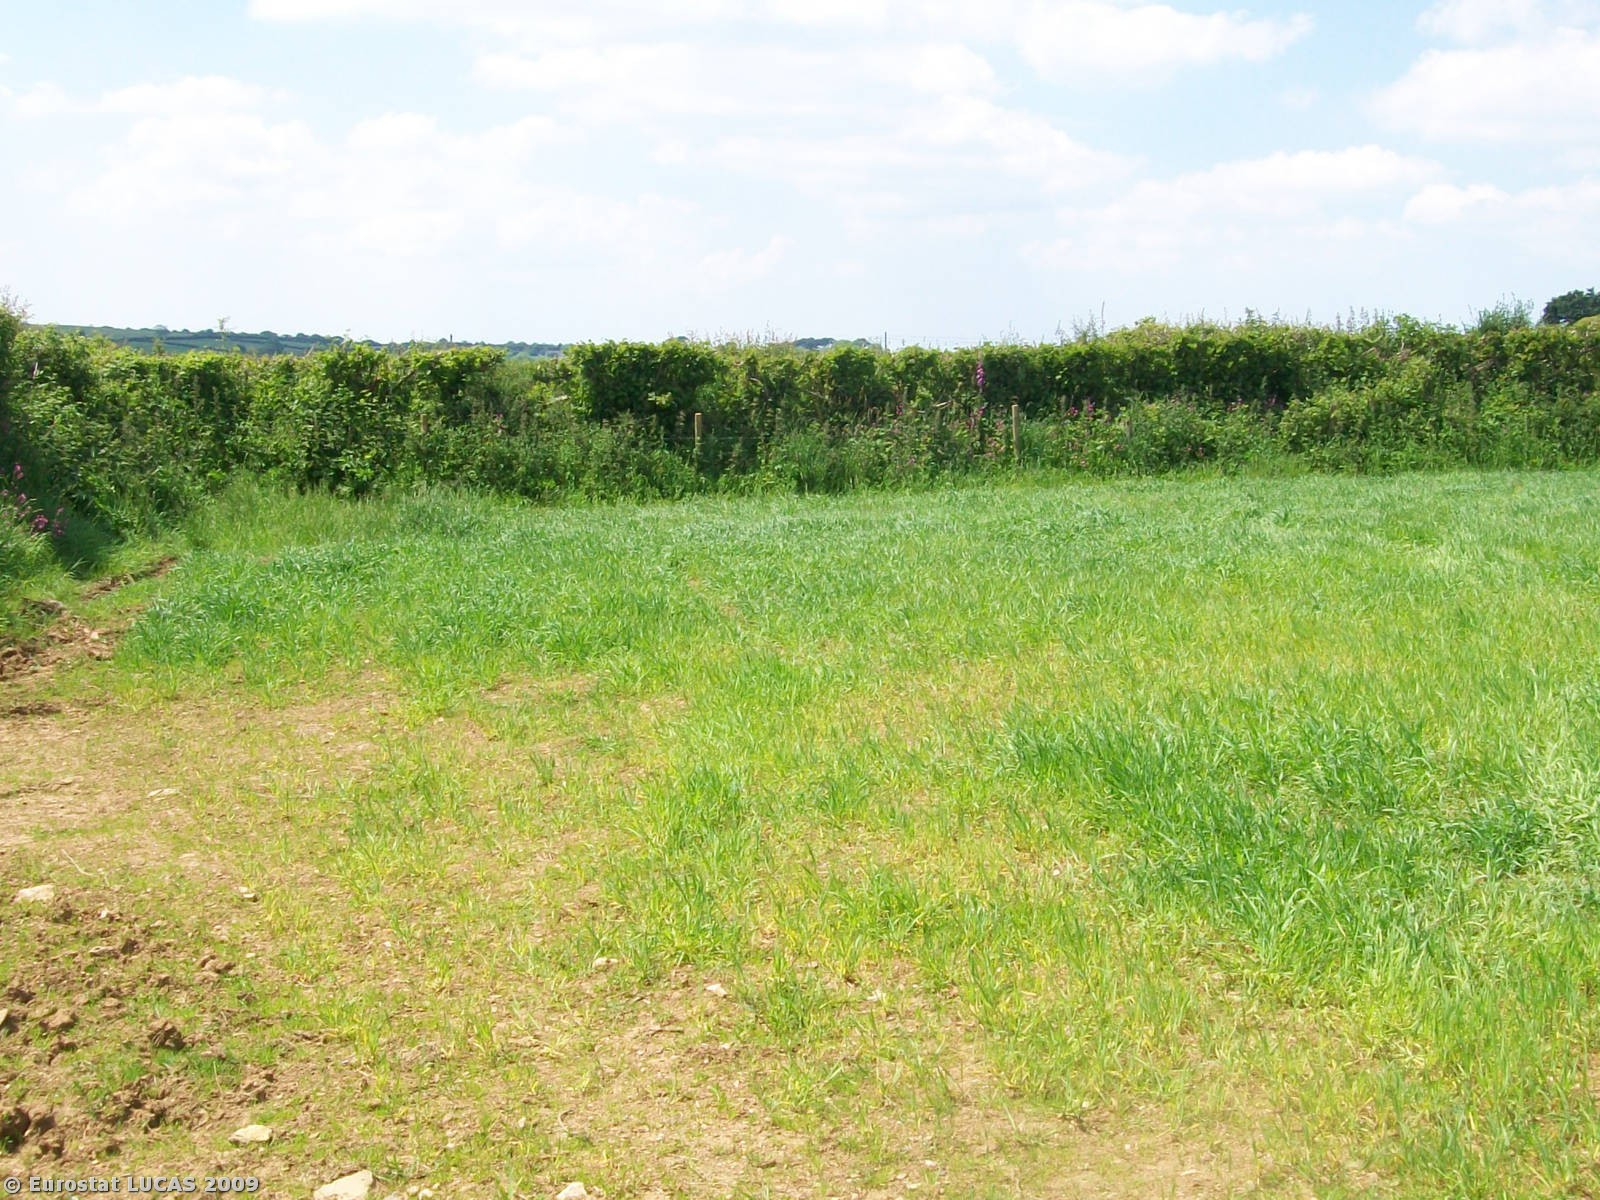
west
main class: Cropland
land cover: Barley
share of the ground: > 75 %
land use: Agriculture (excluding fallow land and kitchen gardens)
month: June
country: GB
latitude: 50.4798
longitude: -4.6078
